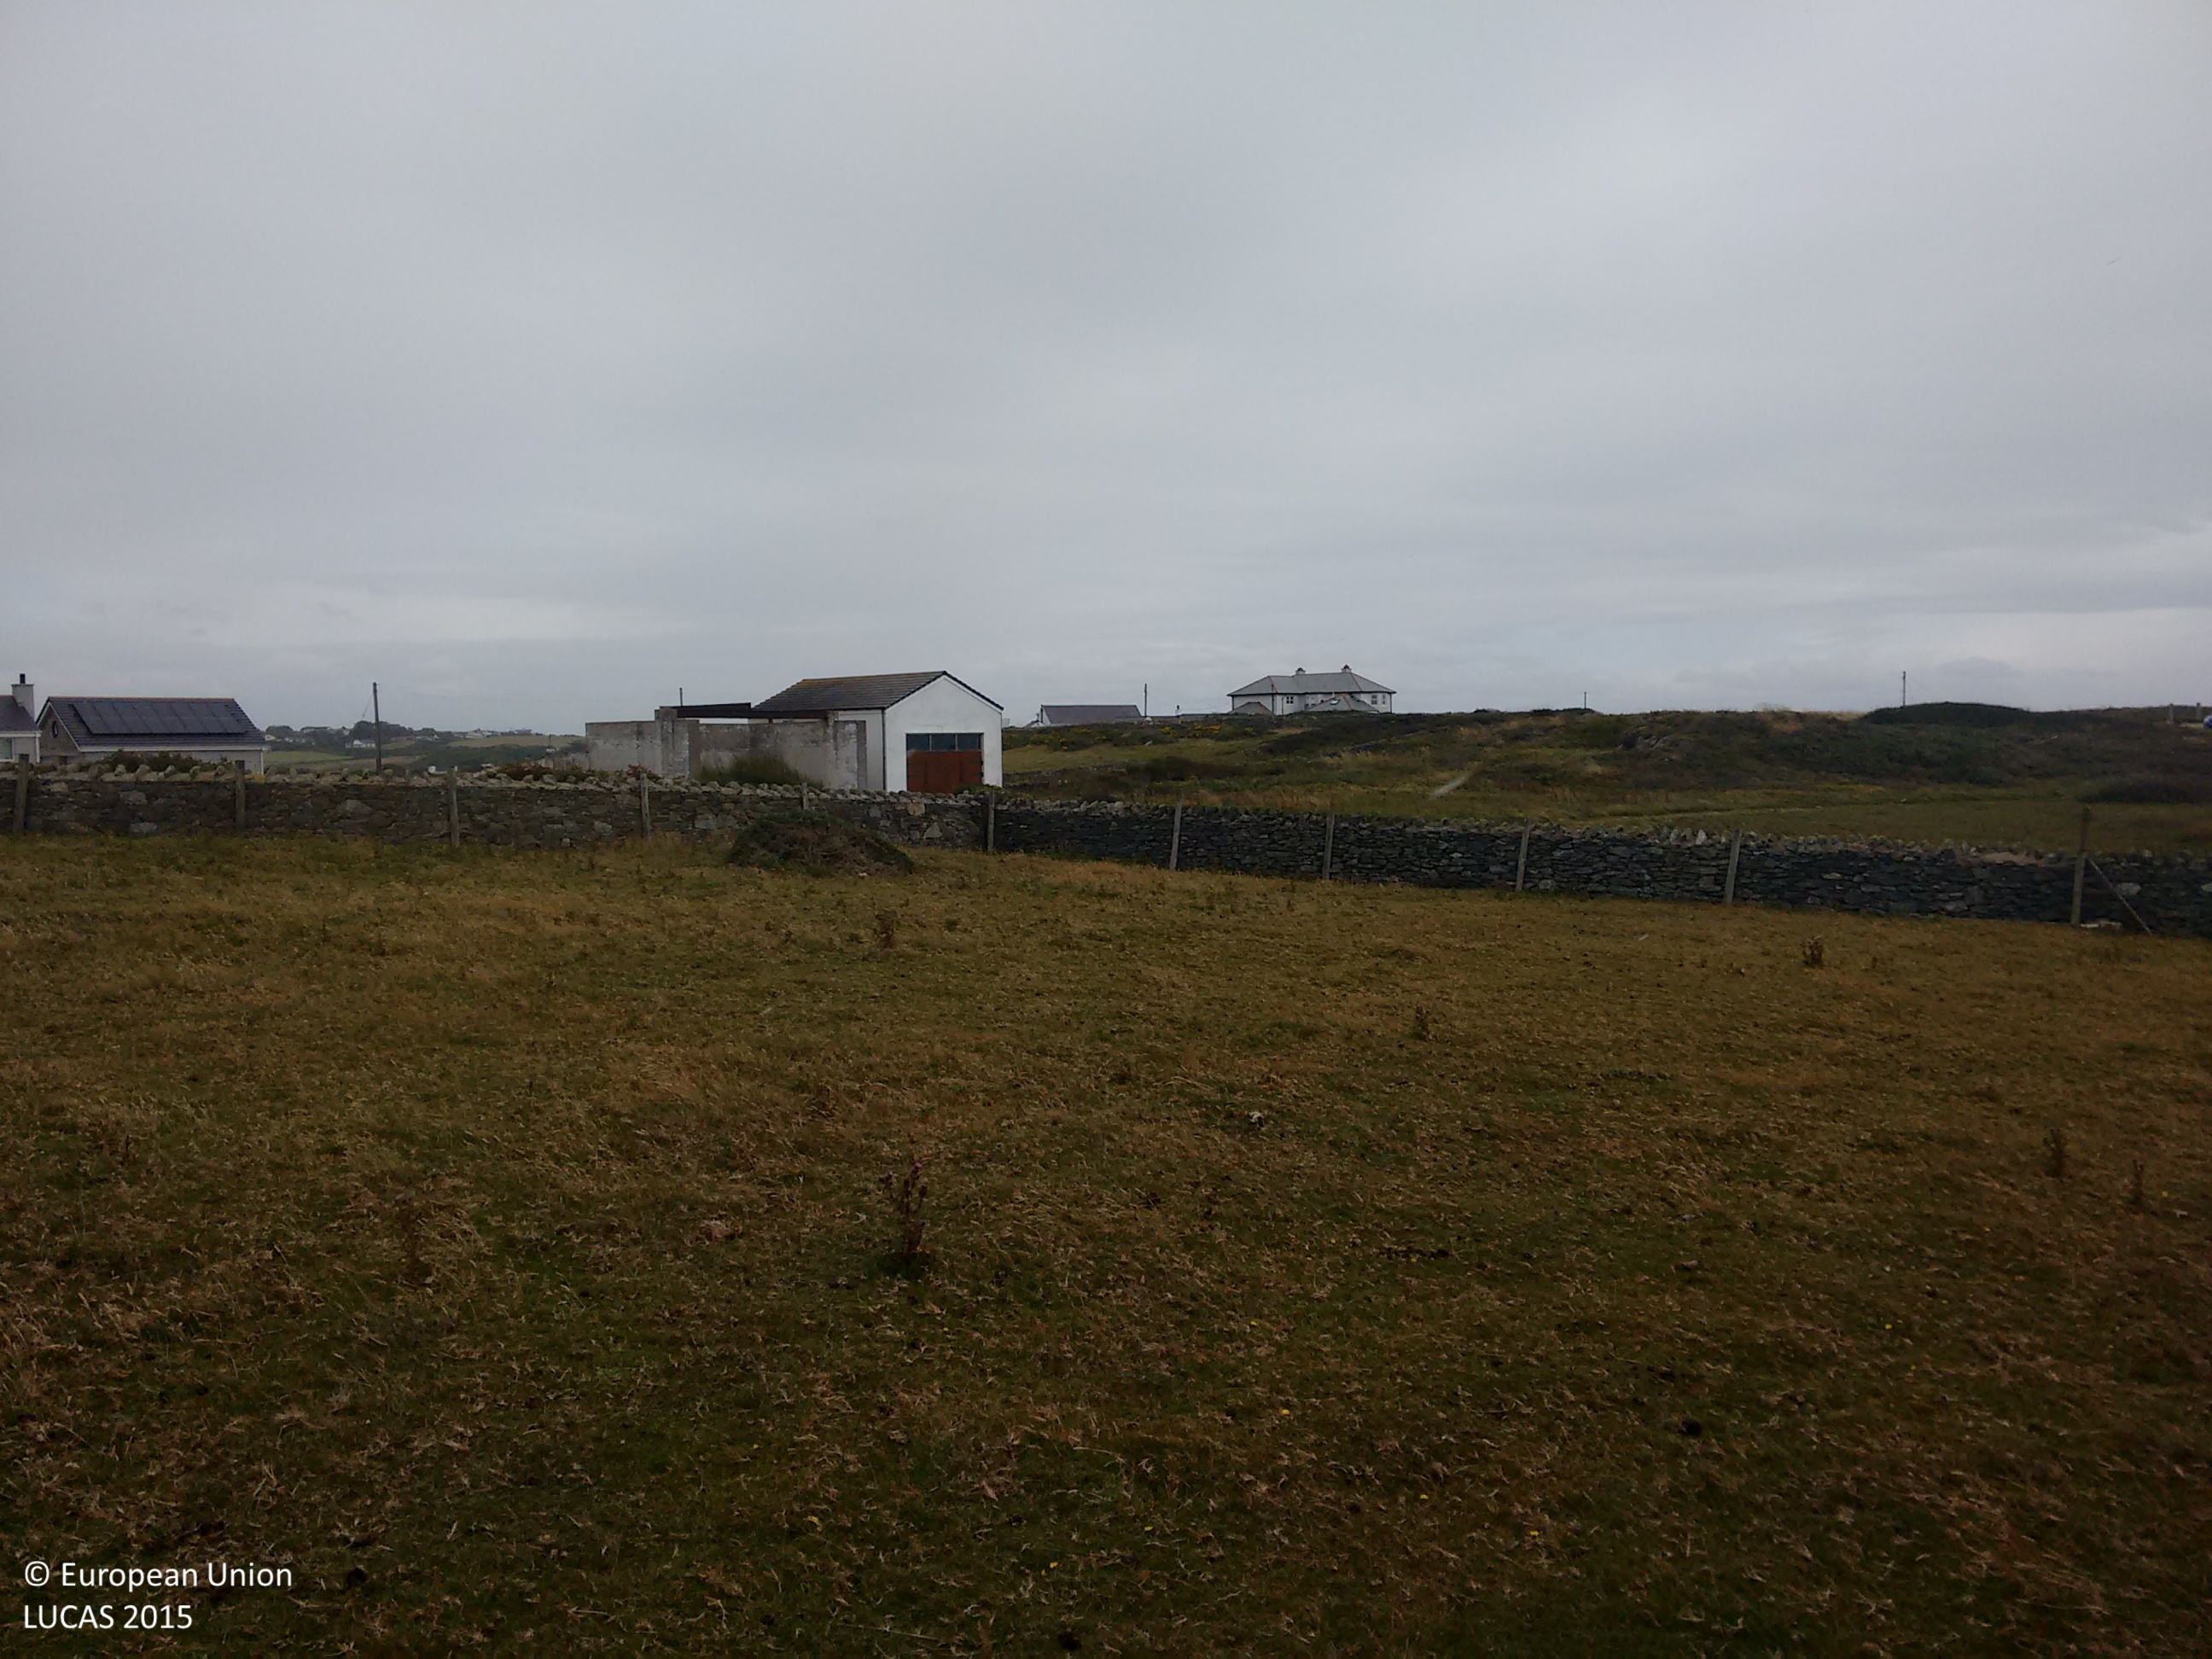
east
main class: Grassland
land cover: Grassland without tree/shrub cover
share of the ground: > 75 %
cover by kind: herbaceous plants 100 %
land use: Agriculture (excluding fallow land and kitchen gardens)
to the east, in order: Grassland without tree/shrub cover; Fences; Grassland without tree/shrub cover; Paved roads, cycling and walking lanes; Grassland without tree/shrub cover; Paved roads, cycling and walking lanes; Grassland without tree/shrub cover; Fences; Grass margins; Tracks; Grass margins; Fences; Grassland without tree/shrub cover; Shrubland without tree cover; Grassland without tree/shrub cover; Fences; Grass margins; Tracks; Grass margins; Fences; Artificial constructions in urban areas; Grassland without tree/shrub cover
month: August
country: GB
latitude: 53.2423
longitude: -4.5974
